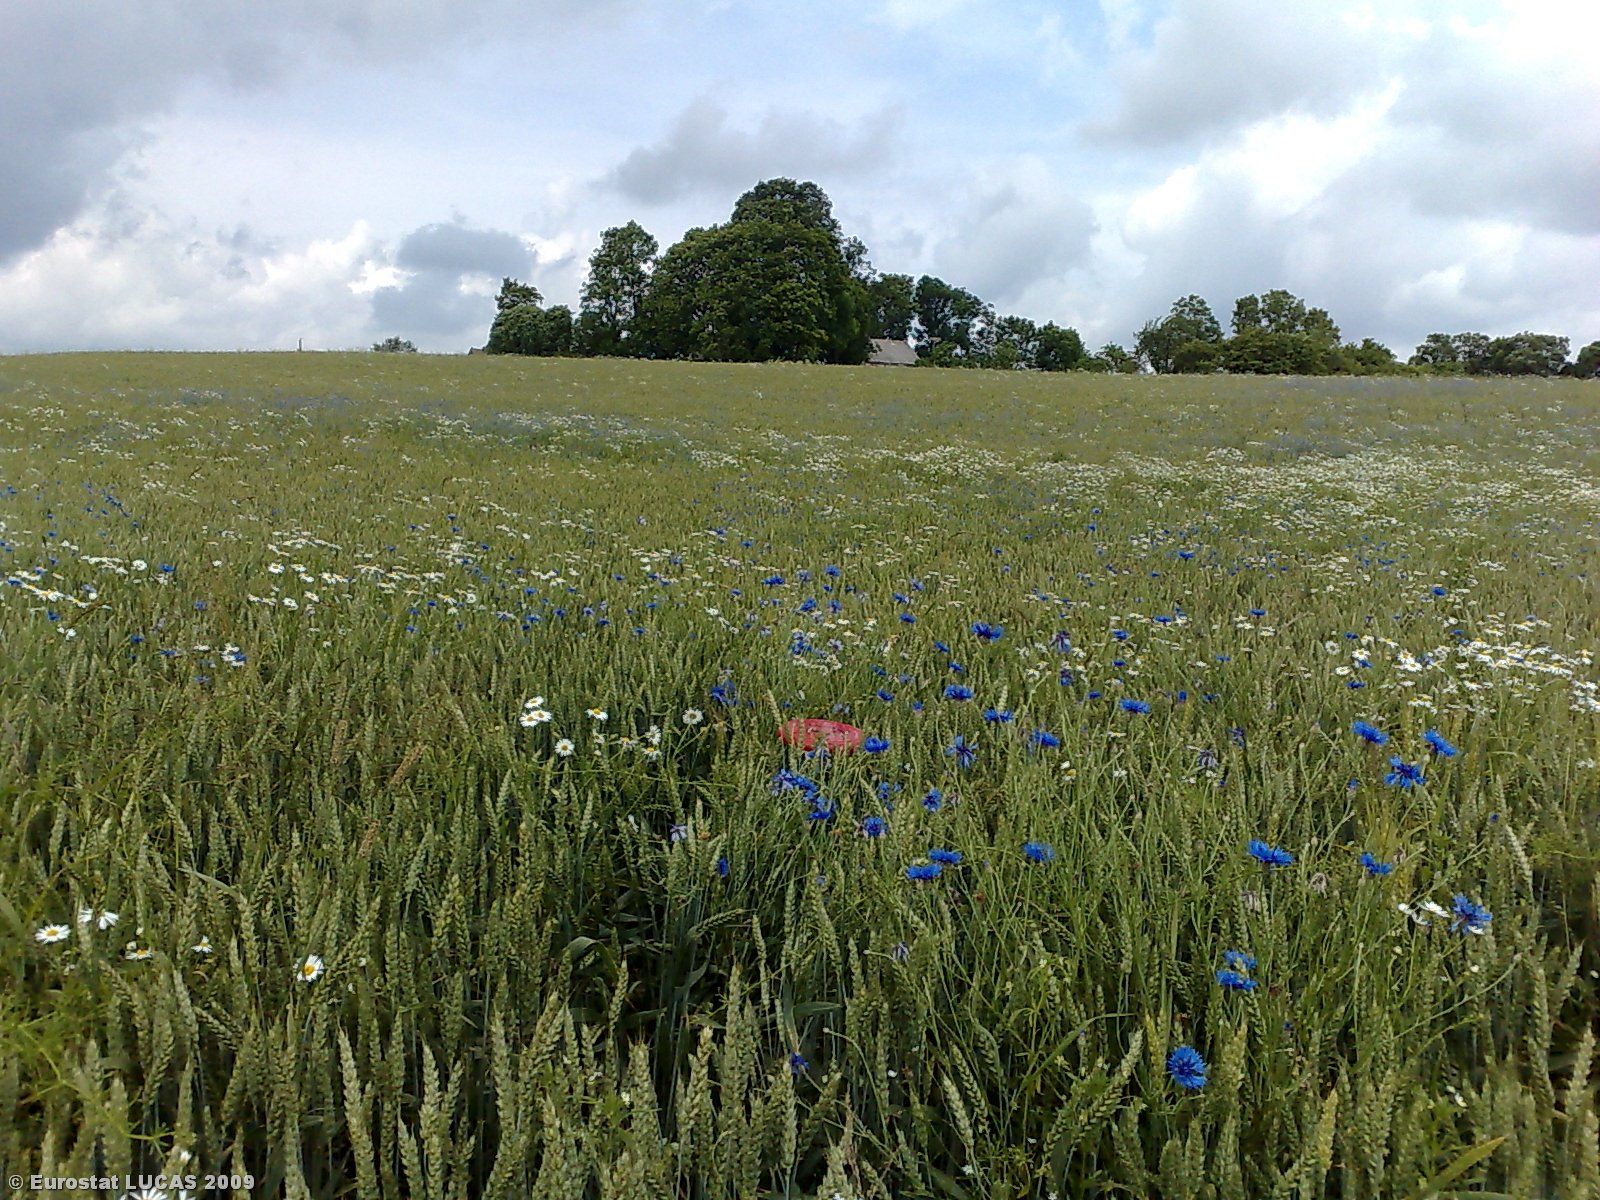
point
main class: Cropland
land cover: Common wheat
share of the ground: > 75 %
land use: Agriculture (excluding fallow land and kitchen gardens)
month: July
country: LT
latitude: 55.6179
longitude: 22.7839
